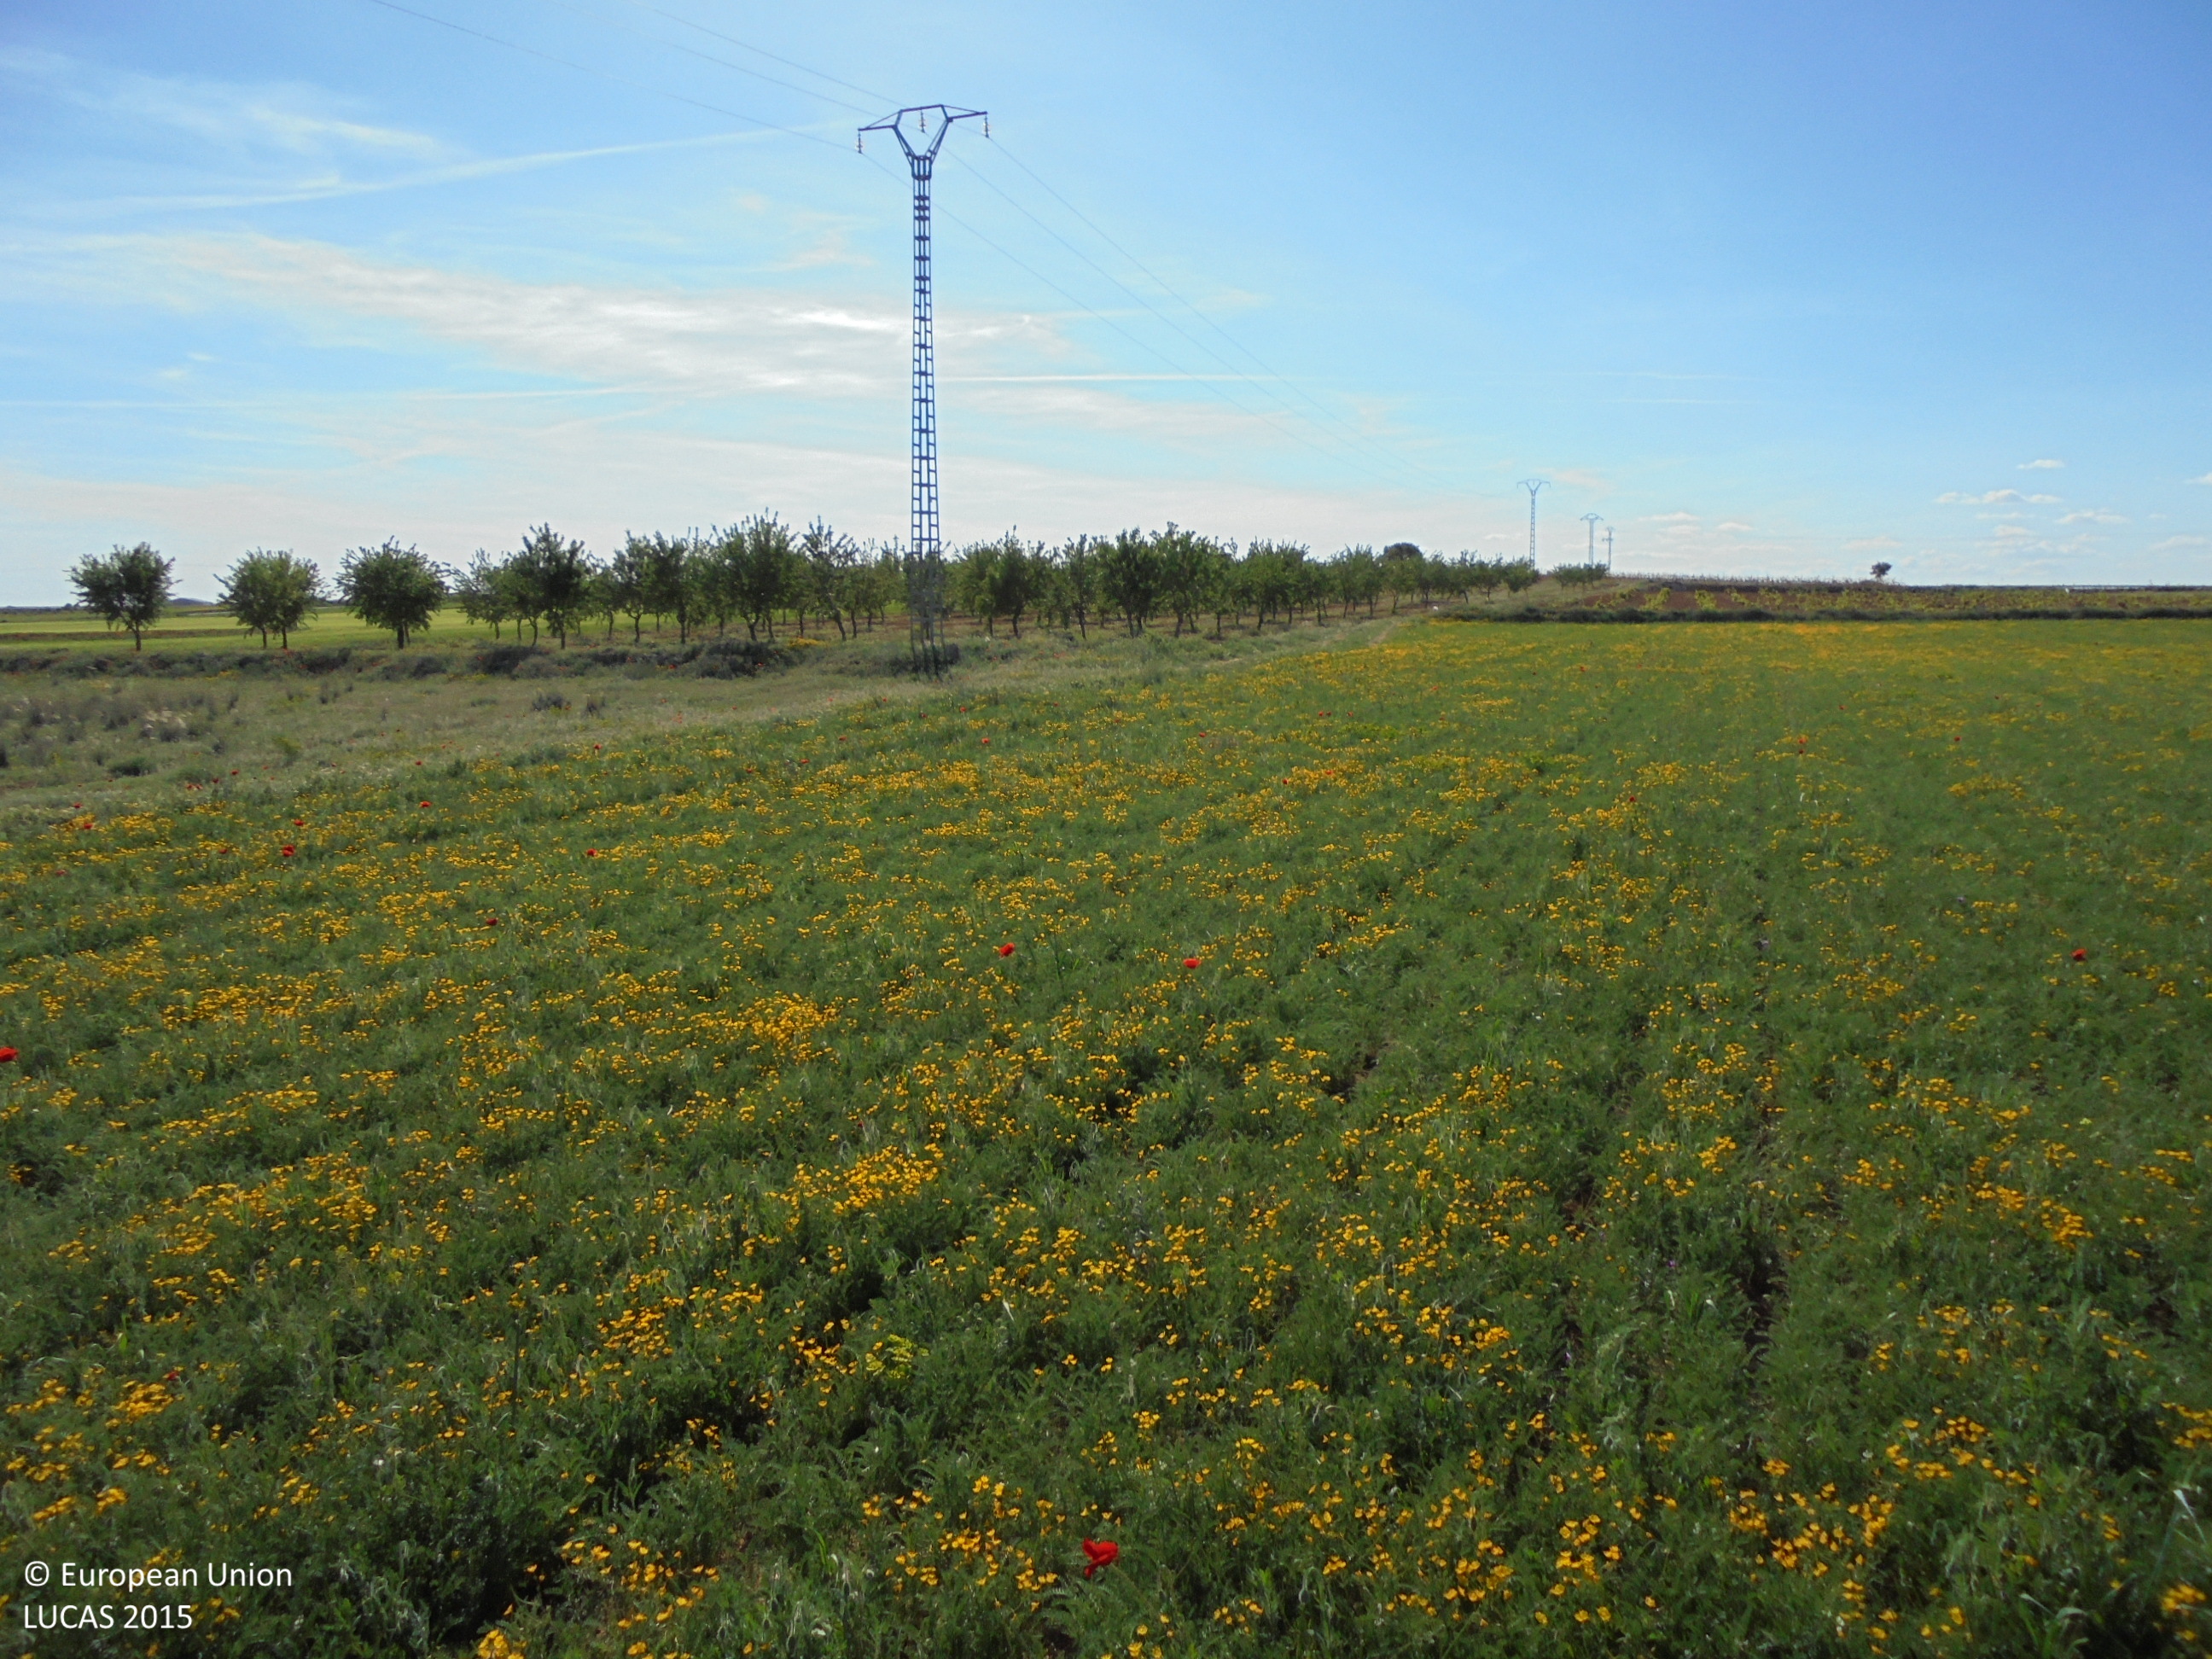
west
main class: Cropland
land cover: Dry pulses
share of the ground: > 75 %
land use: Agriculture (excluding fallow land and kitchen gardens)
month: April
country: ES
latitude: 39.2408
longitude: -1.8093
